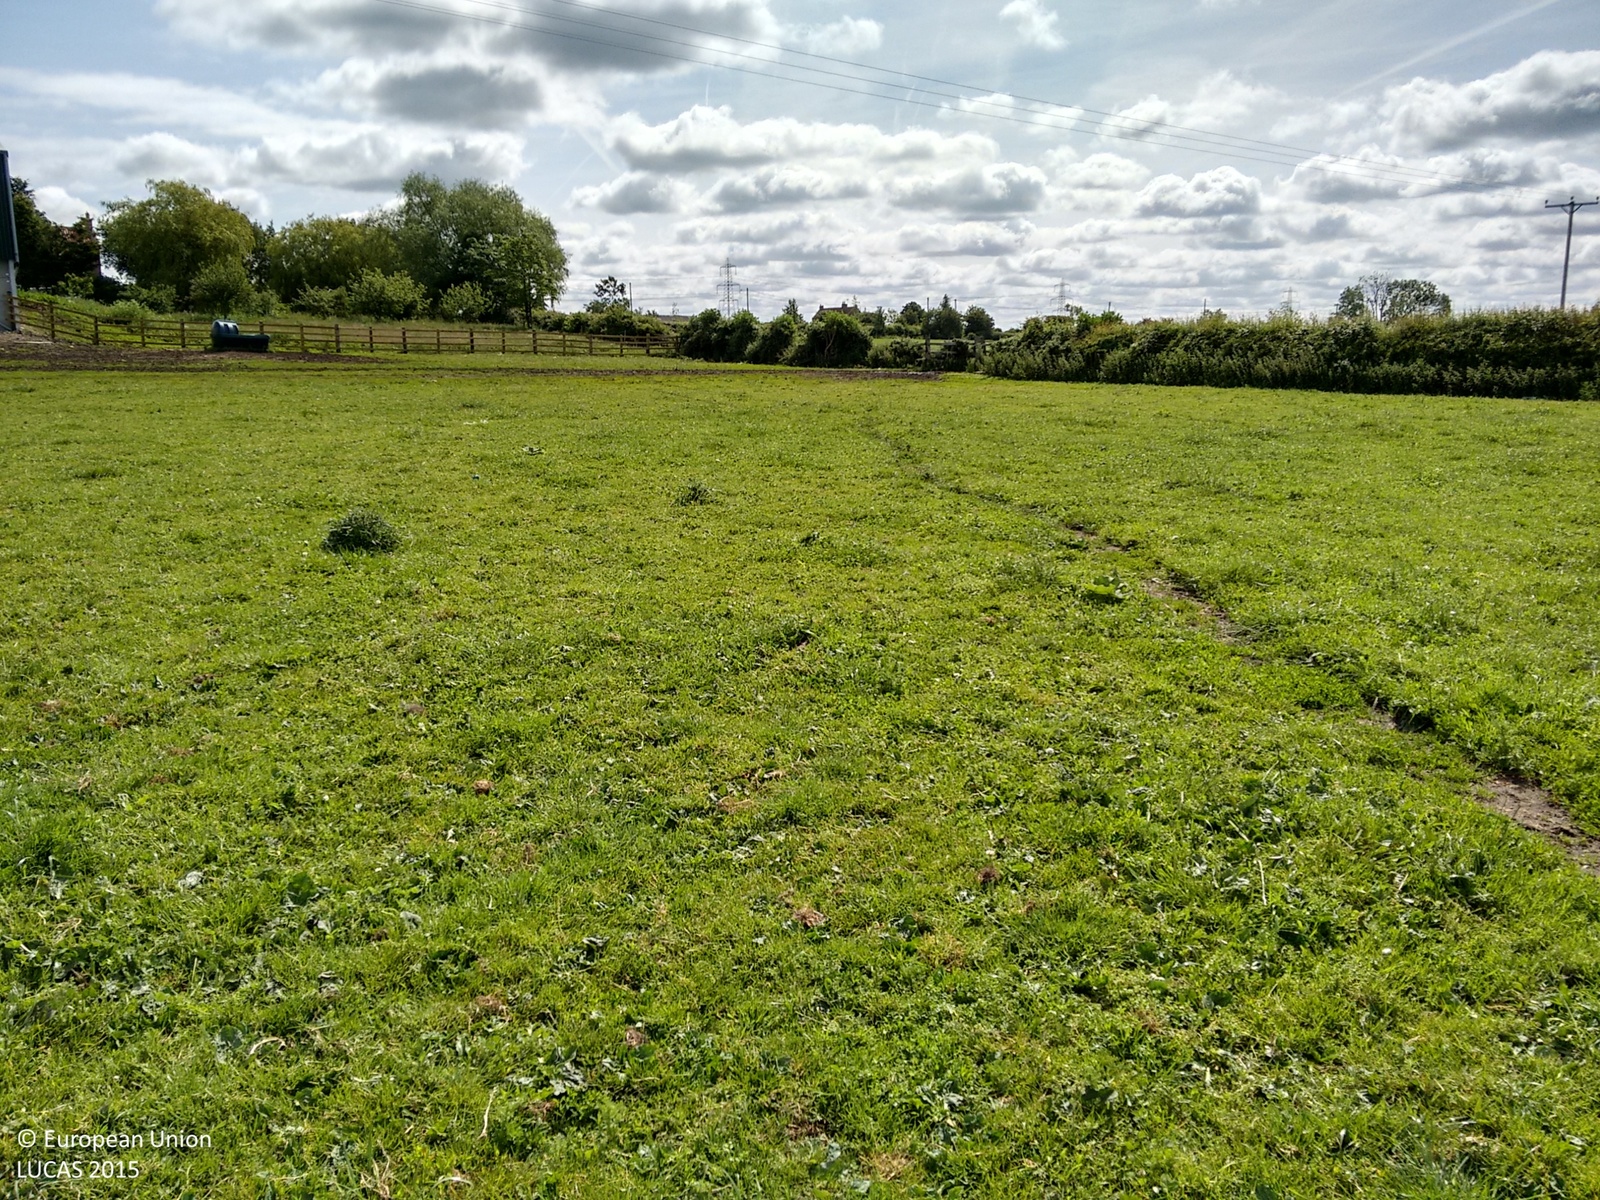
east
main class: Grassland
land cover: Grassland without tree/shrub cover
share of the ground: > 75 %
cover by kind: herbaceous plants 100 %
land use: Agriculture (excluding fallow land and kitchen gardens)
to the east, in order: Grassland without tree/shrub cover; Electric lines; Grassland without tree/shrub cover; Fences; Grassland without tree/shrub cover; Managed hedges; Ditches and canals; Fences; Grassland without tree/shrub cover; Fences; Ditches and canals; Managed hedges; Grass margins; Electric lines; Grass margins; Paved roads, cycling and walking lanes; Grass margins; Electric lines; Managed hedges; Grassland without tree/shrub cover
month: June
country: GB
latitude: 53.2710
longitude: -0.7011
